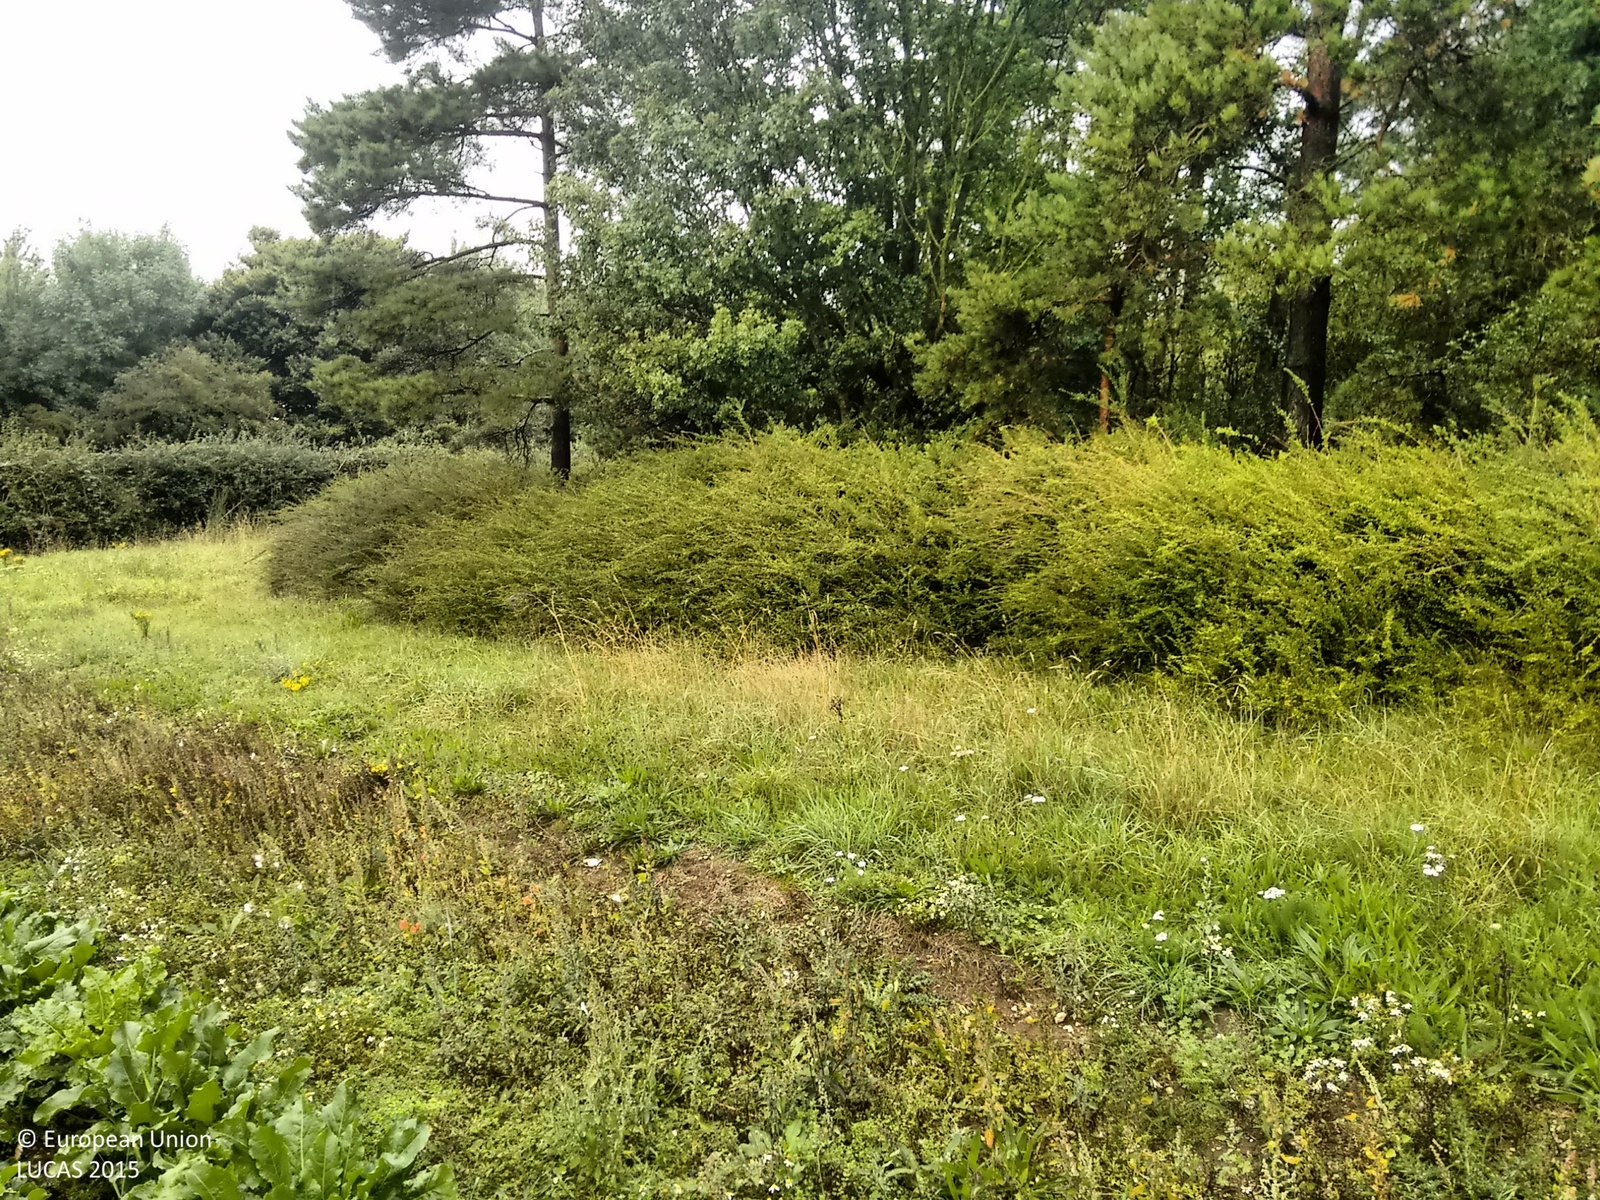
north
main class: Cropland
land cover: Sugar beet
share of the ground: > 75 %
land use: Agriculture (excluding fallow land and kitchen gardens)
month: September
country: GB
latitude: 52.2192
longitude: 0.3540
